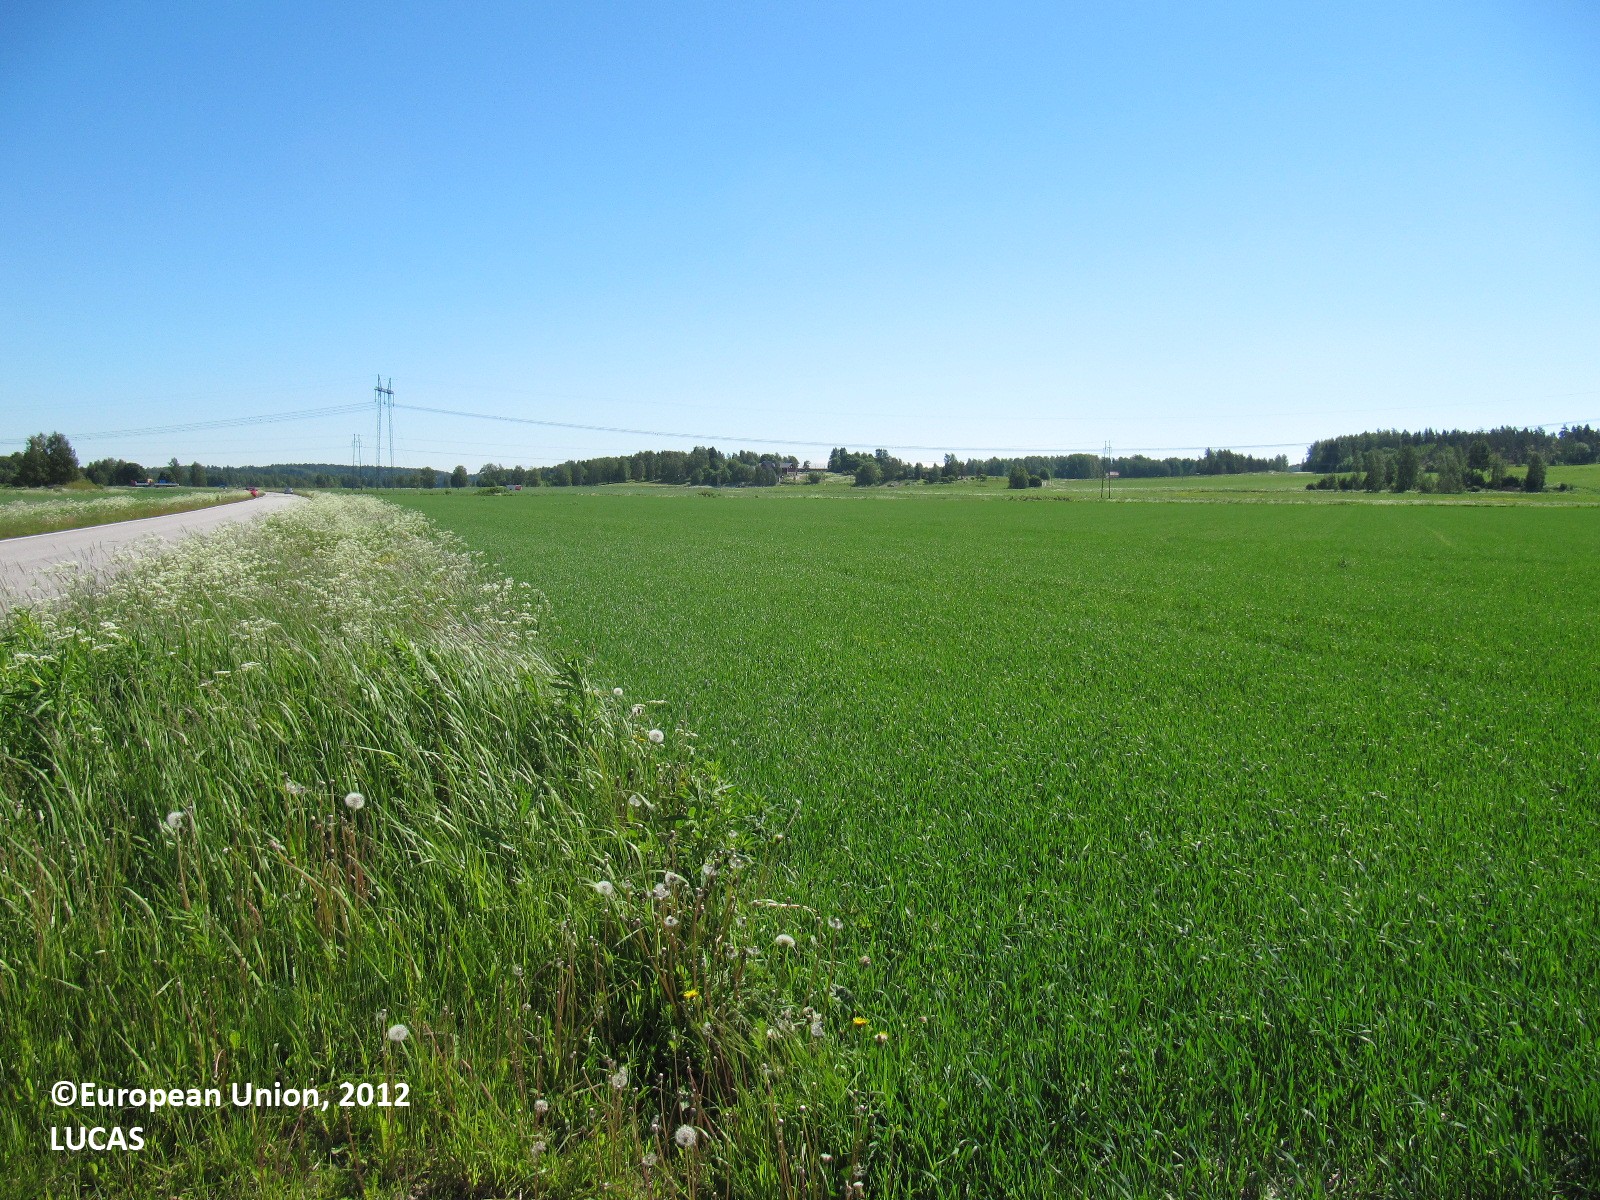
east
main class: Cropland
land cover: Common wheat
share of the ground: > 75 %
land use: Agriculture (excluding fallow land and kitchen gardens)
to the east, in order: Common wheat; Ditches and canals; Common wheat
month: June
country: FI
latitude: 60.1144
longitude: 24.2273
